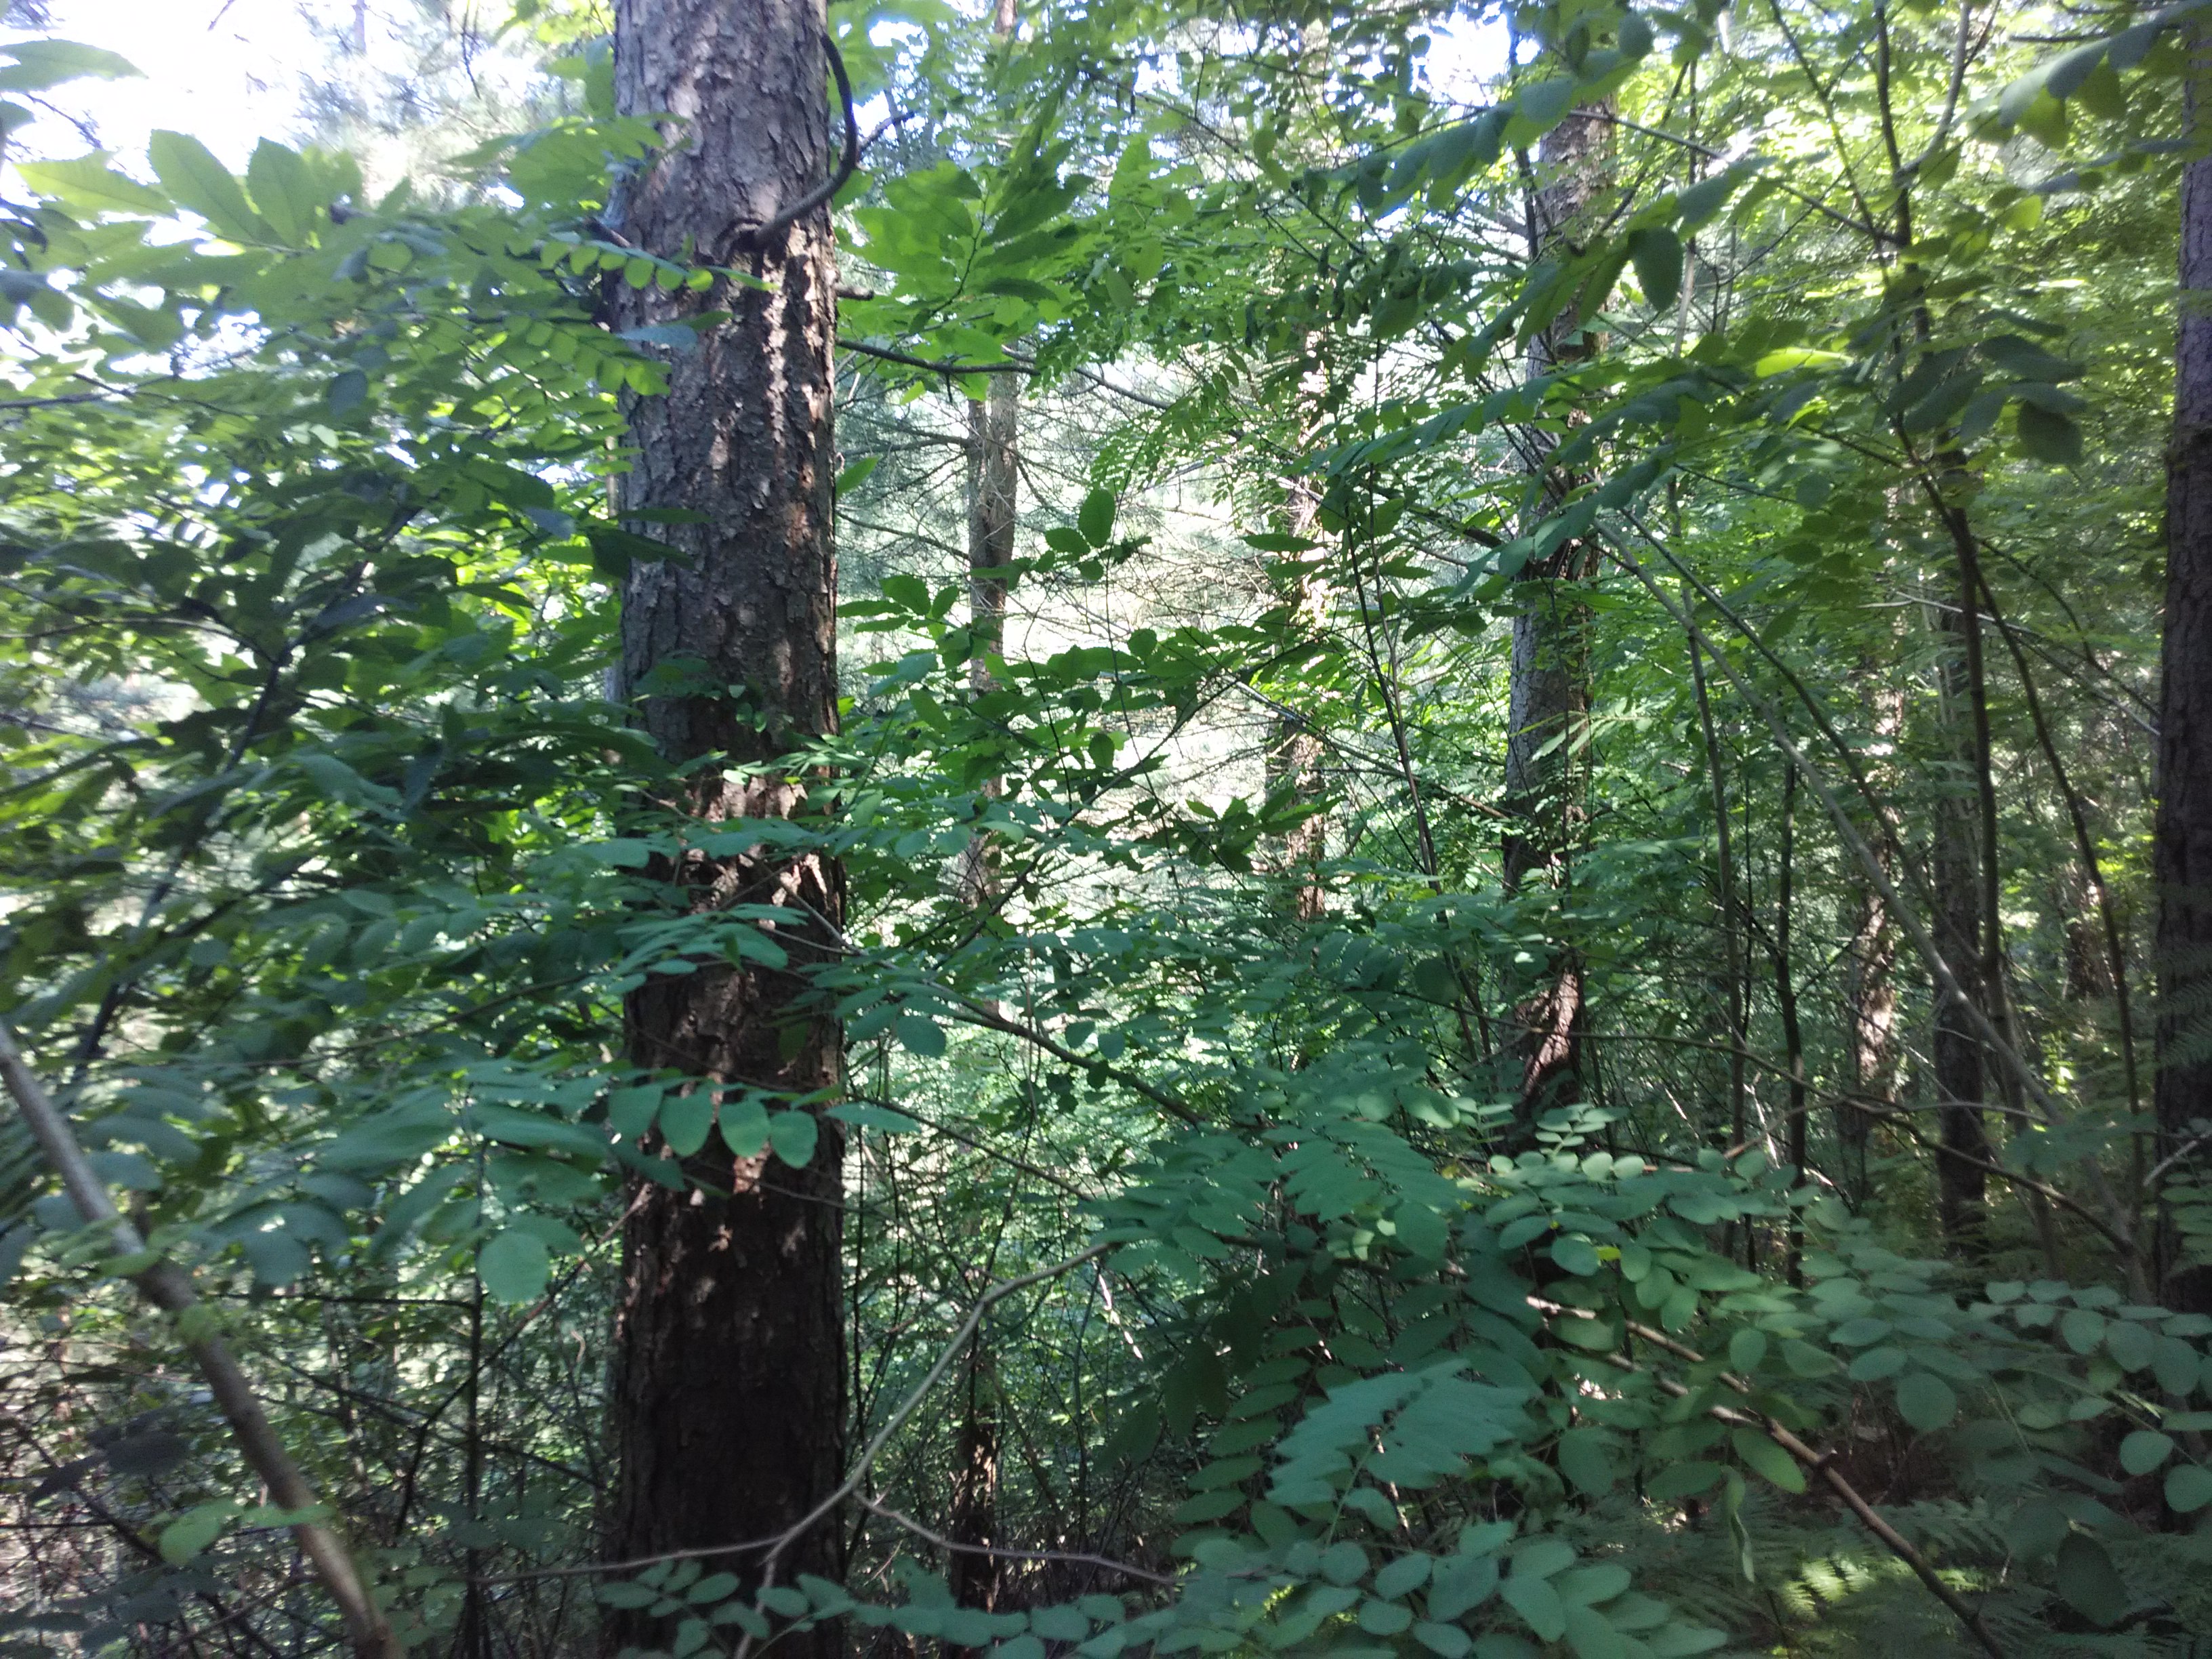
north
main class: Woodland
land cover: Pine dominated mixed woodland
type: exotic forest
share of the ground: > 75 %
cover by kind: coniferous forest trees 70 %, broadleaved forest trees 30 %
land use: Forestry
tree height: > 5 m
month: June
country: ES
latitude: 43.0401
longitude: -2.3856
